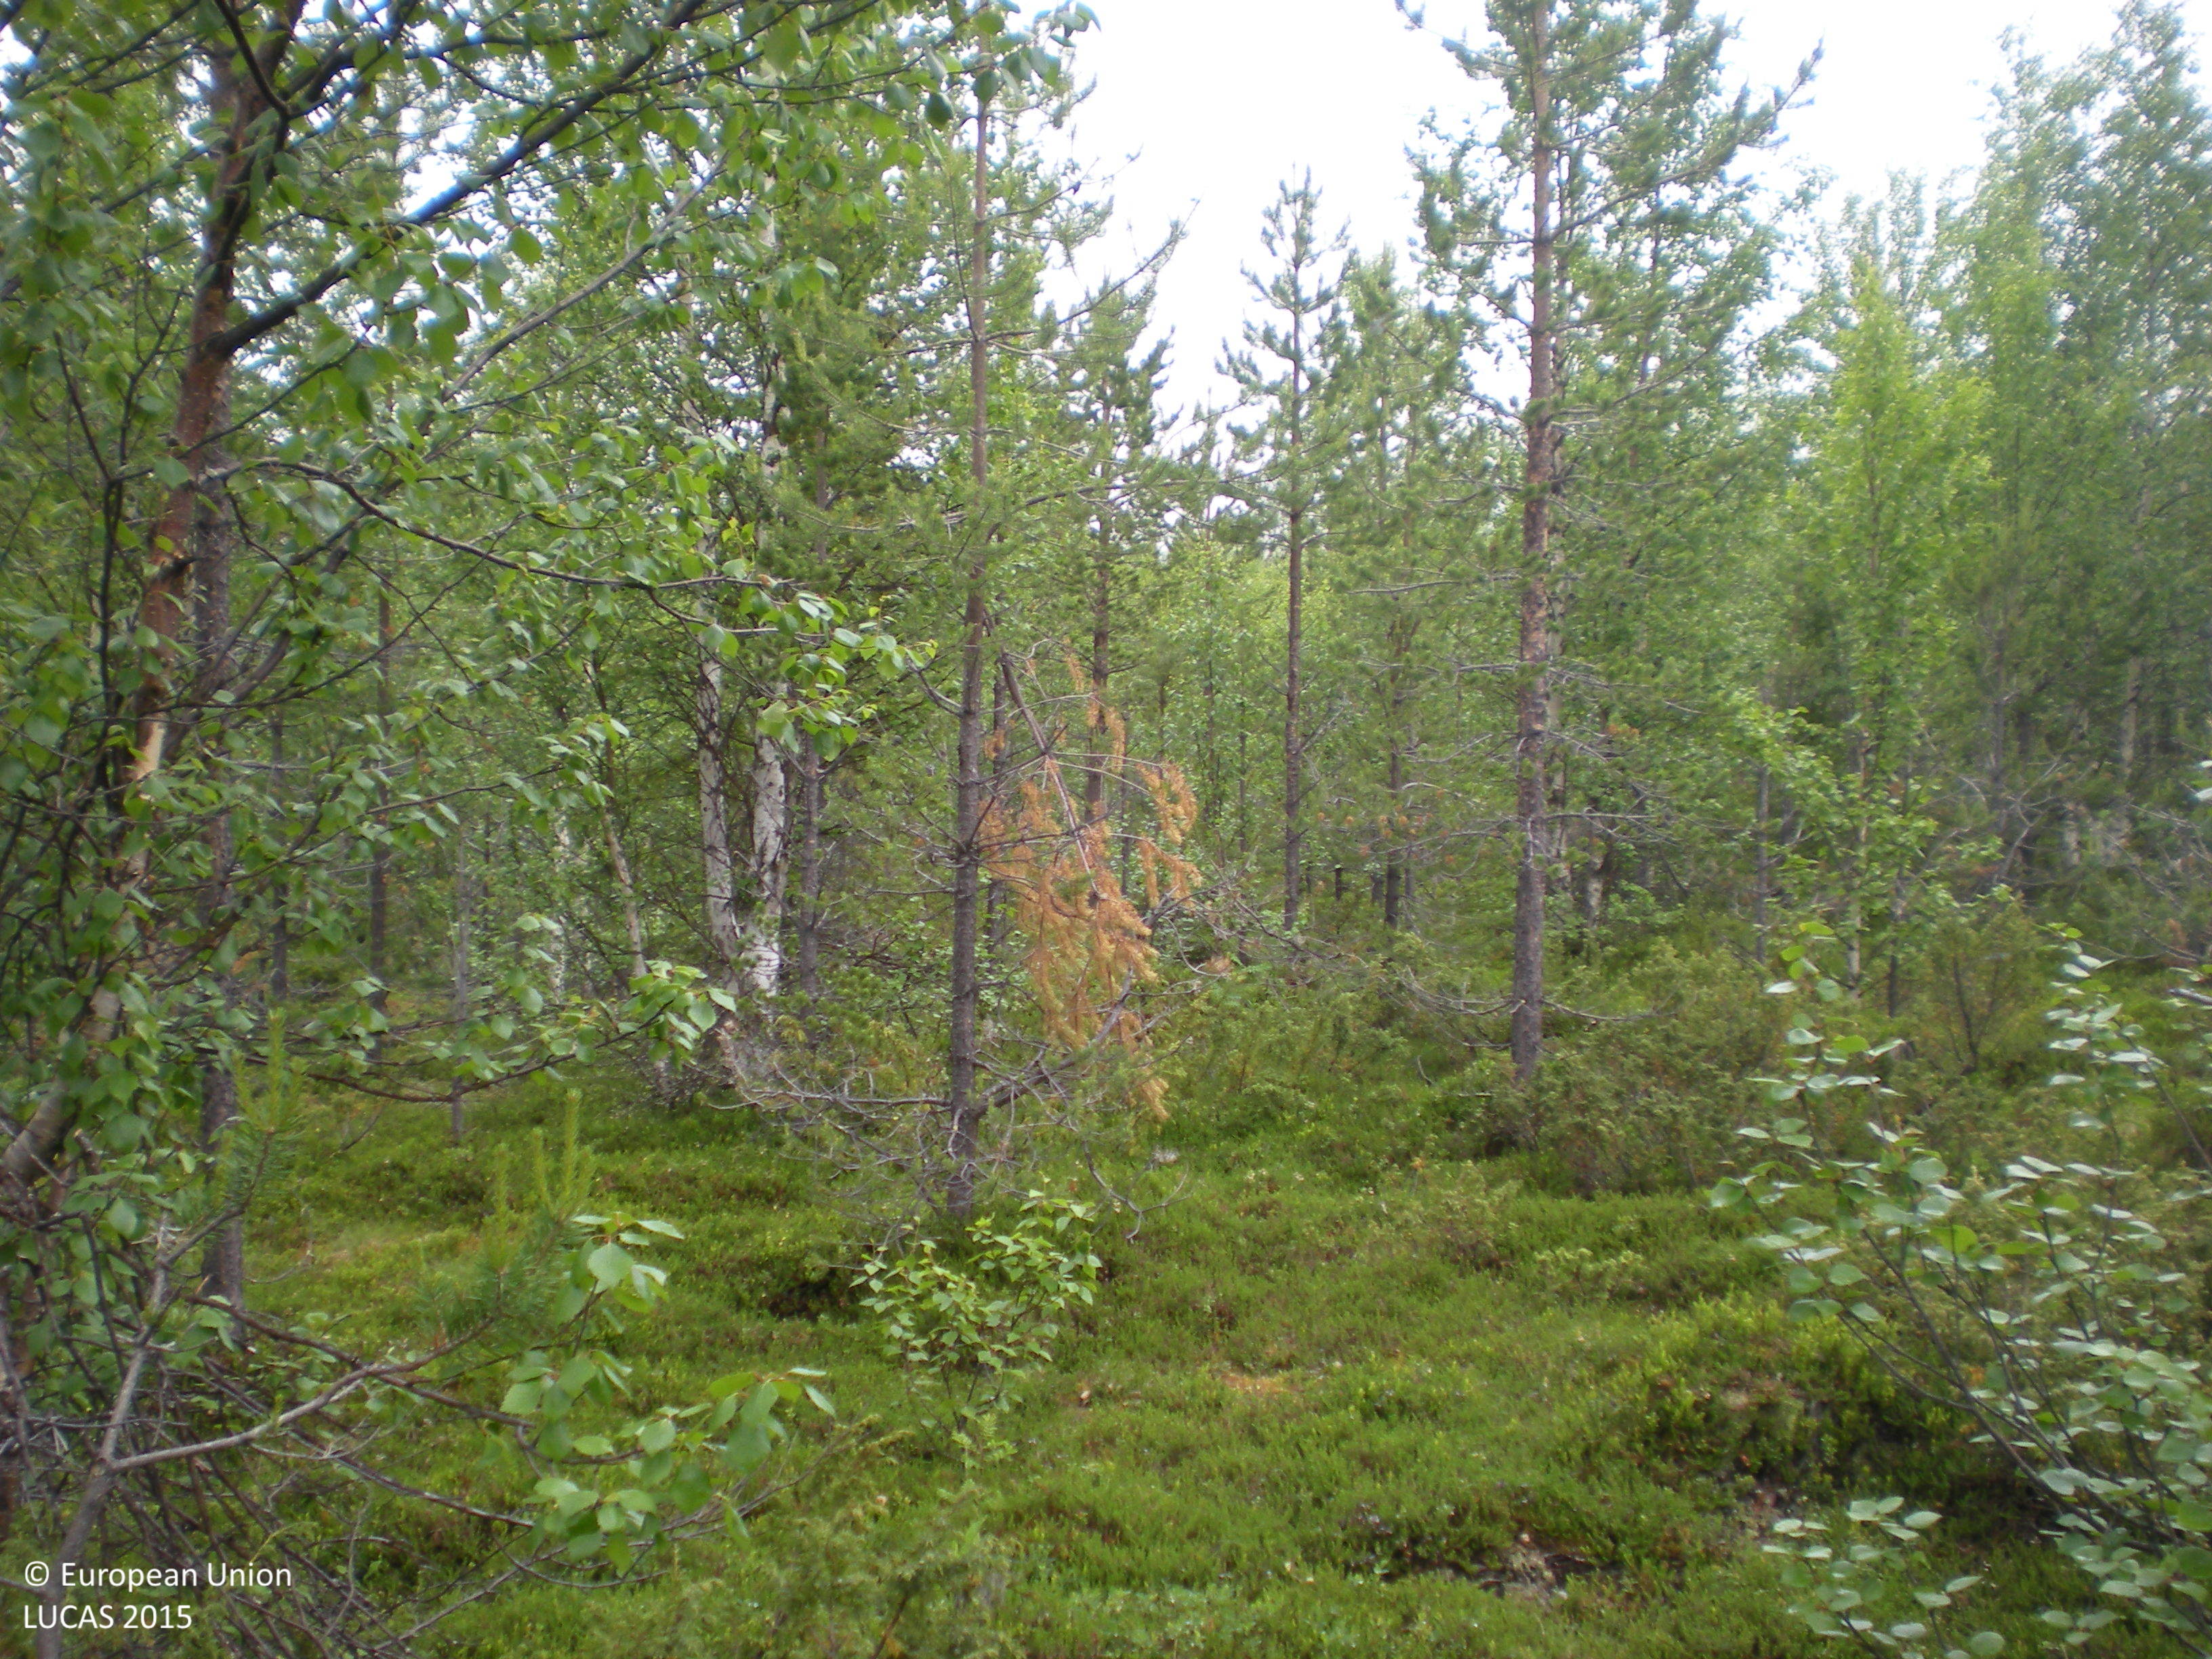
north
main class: Woodland
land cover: Pine dominated mixed woodland
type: boreal forest
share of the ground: 50 - 75 %
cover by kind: coniferous forest trees 45 %, shrubs 30 %, broadleaved forest trees 15 %, lichens and mosses 10 %
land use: Forestry
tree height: > 5 m
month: July
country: SE
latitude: 65.7566
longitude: 17.2697
